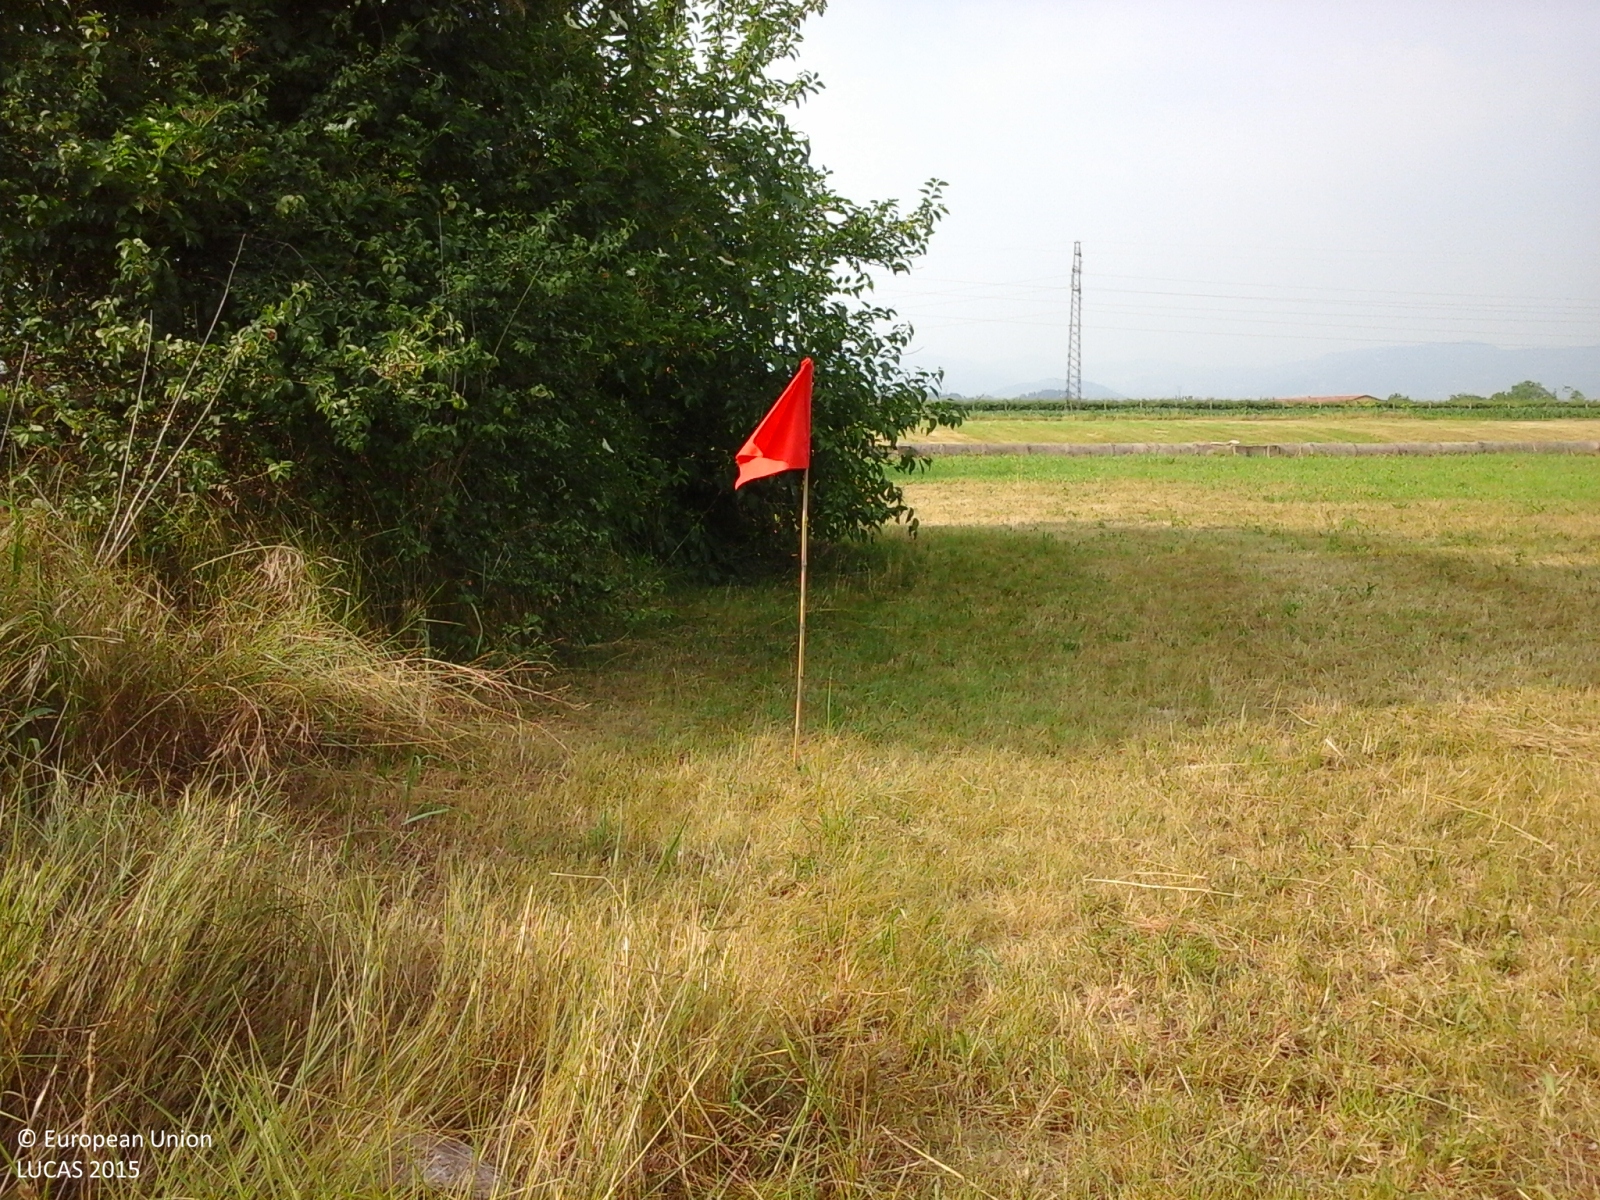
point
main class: Grassland
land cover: Spontaneously vegetated surfaces
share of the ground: > 75 %
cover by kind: herbaceous plants 100 %
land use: Agriculture (excluding fallow land and kitchen gardens)
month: June
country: IT
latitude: 45.4647
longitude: 10.8810
